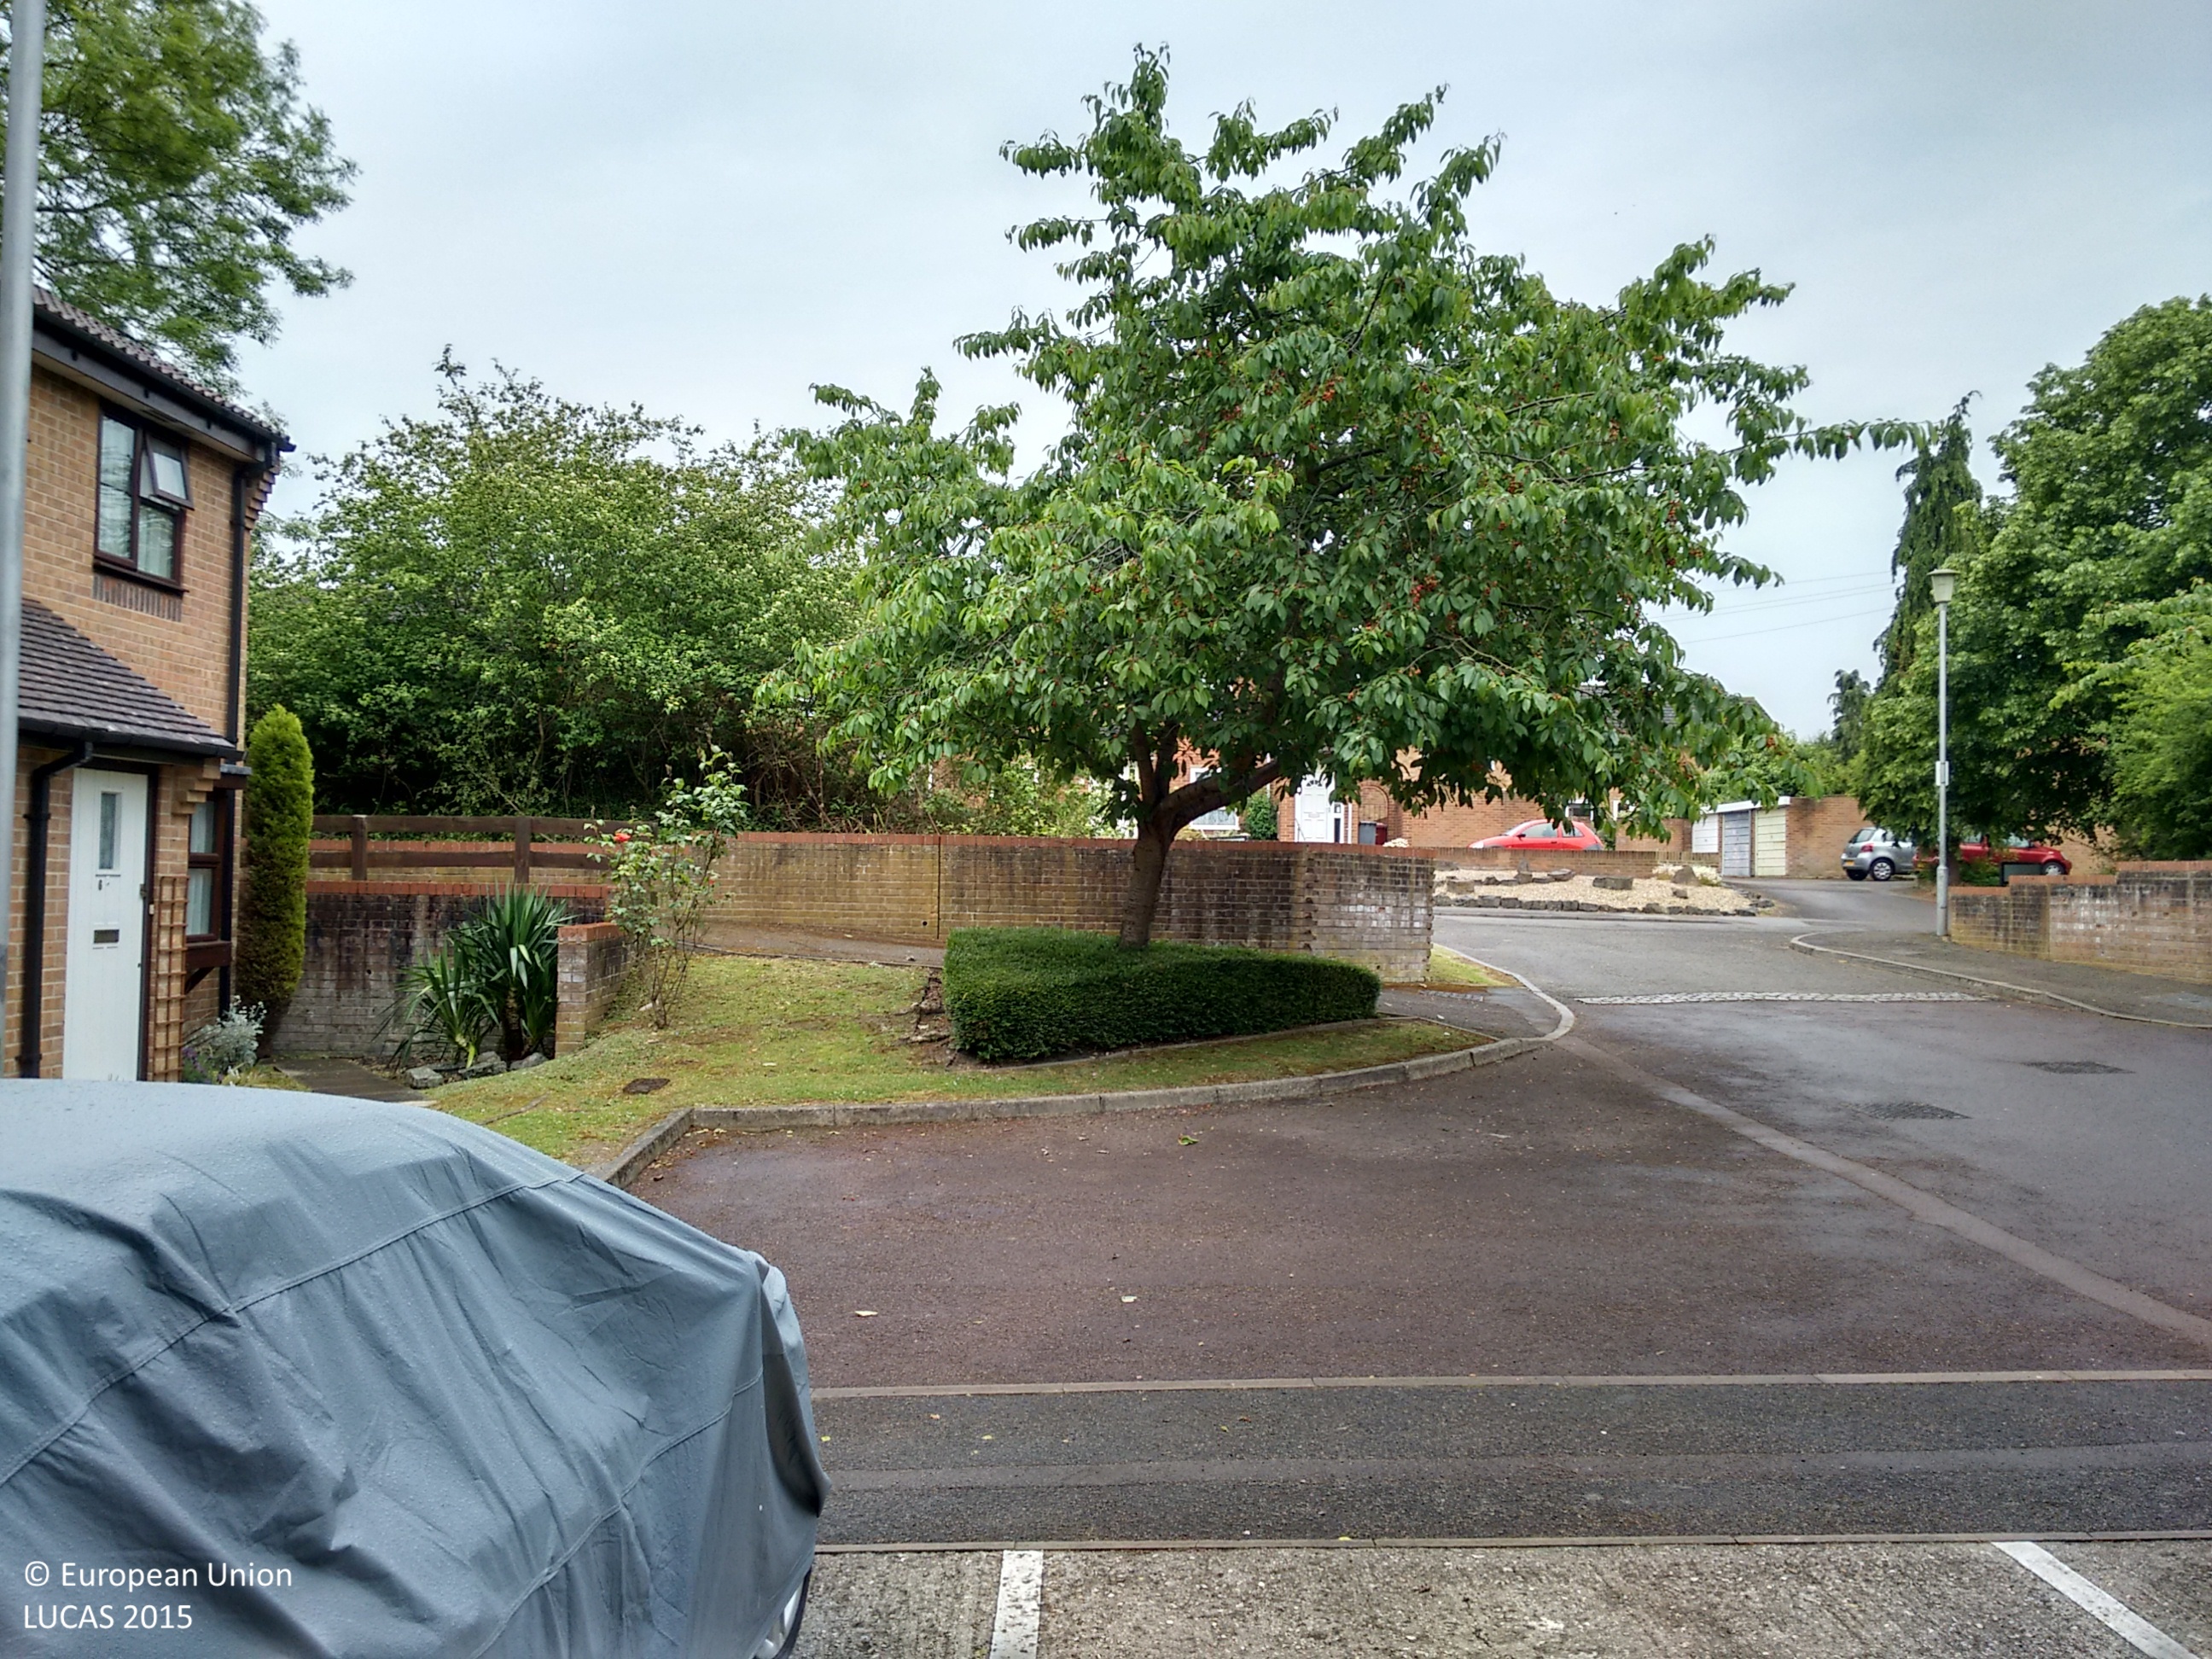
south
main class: Woodland
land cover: Broadleaved woodland
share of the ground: > 75 %
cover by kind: broadleaved forest trees 70 %, herbaceous plants 30 %
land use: Residential
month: June
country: GB
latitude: 51.4627
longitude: -1.0272
